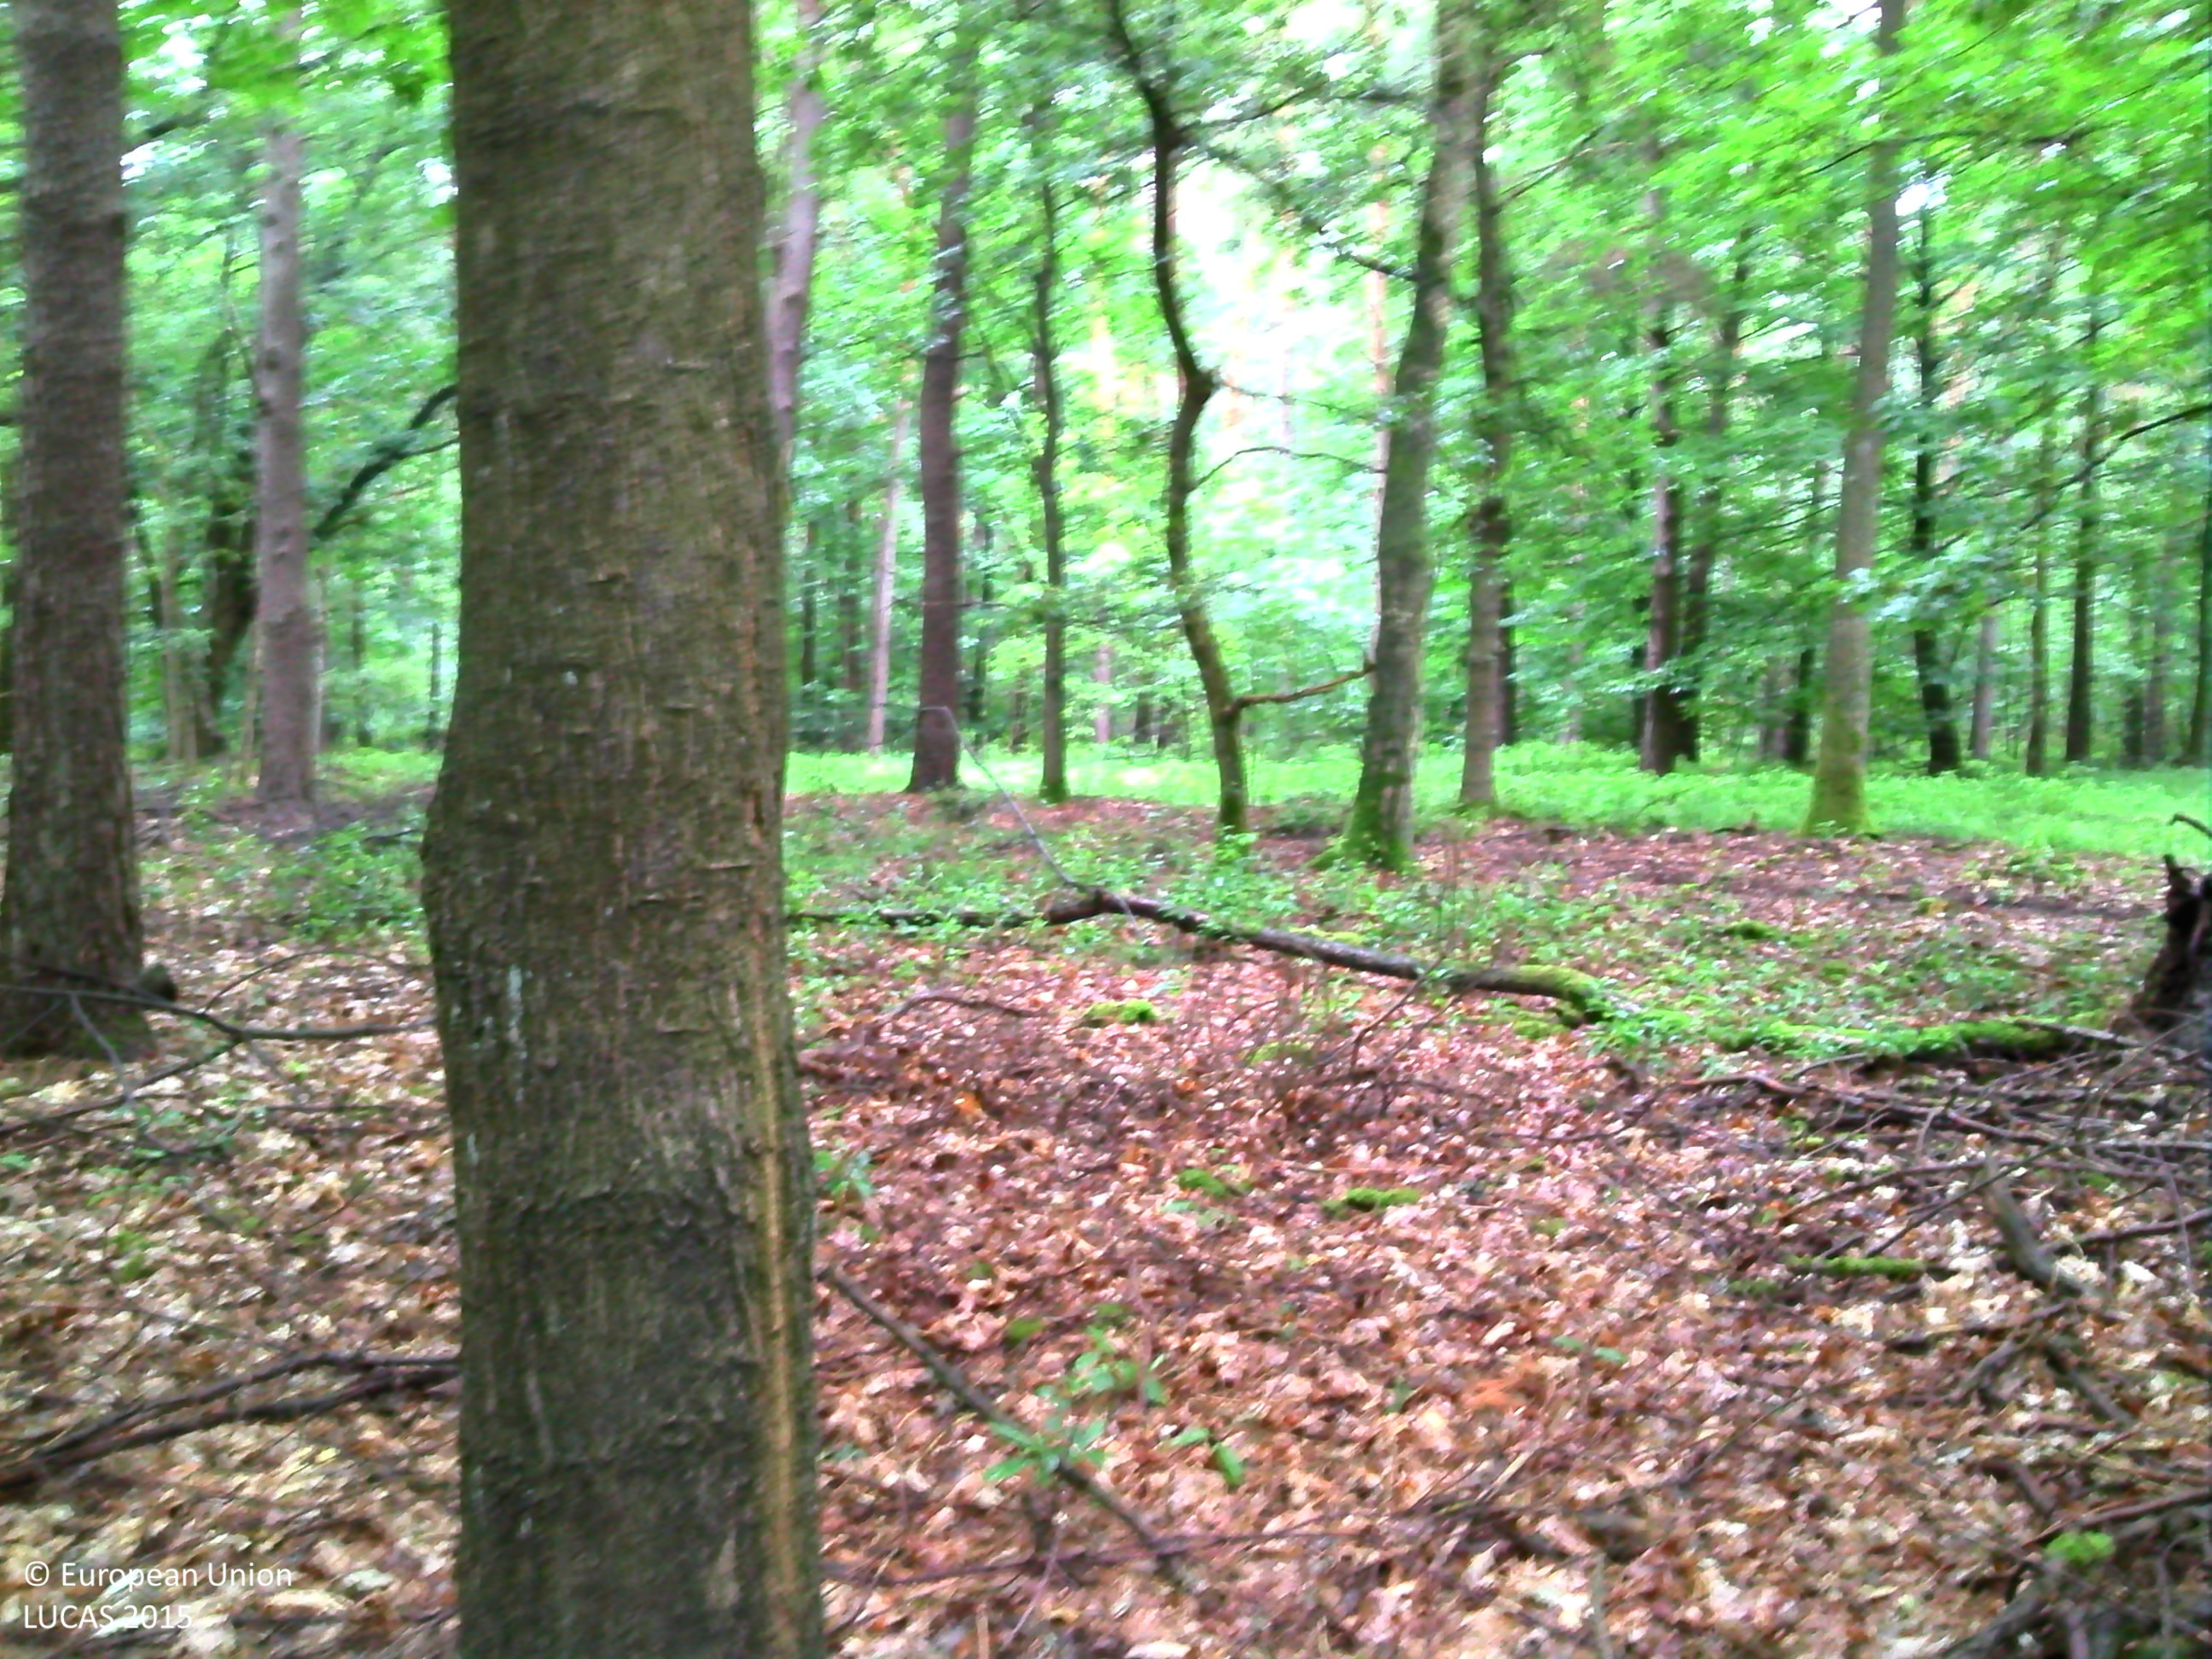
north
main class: Woodland
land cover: Pine dominated mixed woodland
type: mesophytic deciduous forest
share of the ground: > 75 %
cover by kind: coniferous forest trees 65 %, broadleaved forest trees 35 %
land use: Forestry
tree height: > 5 m
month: August
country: BE
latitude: 50.9805
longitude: 5.5685
